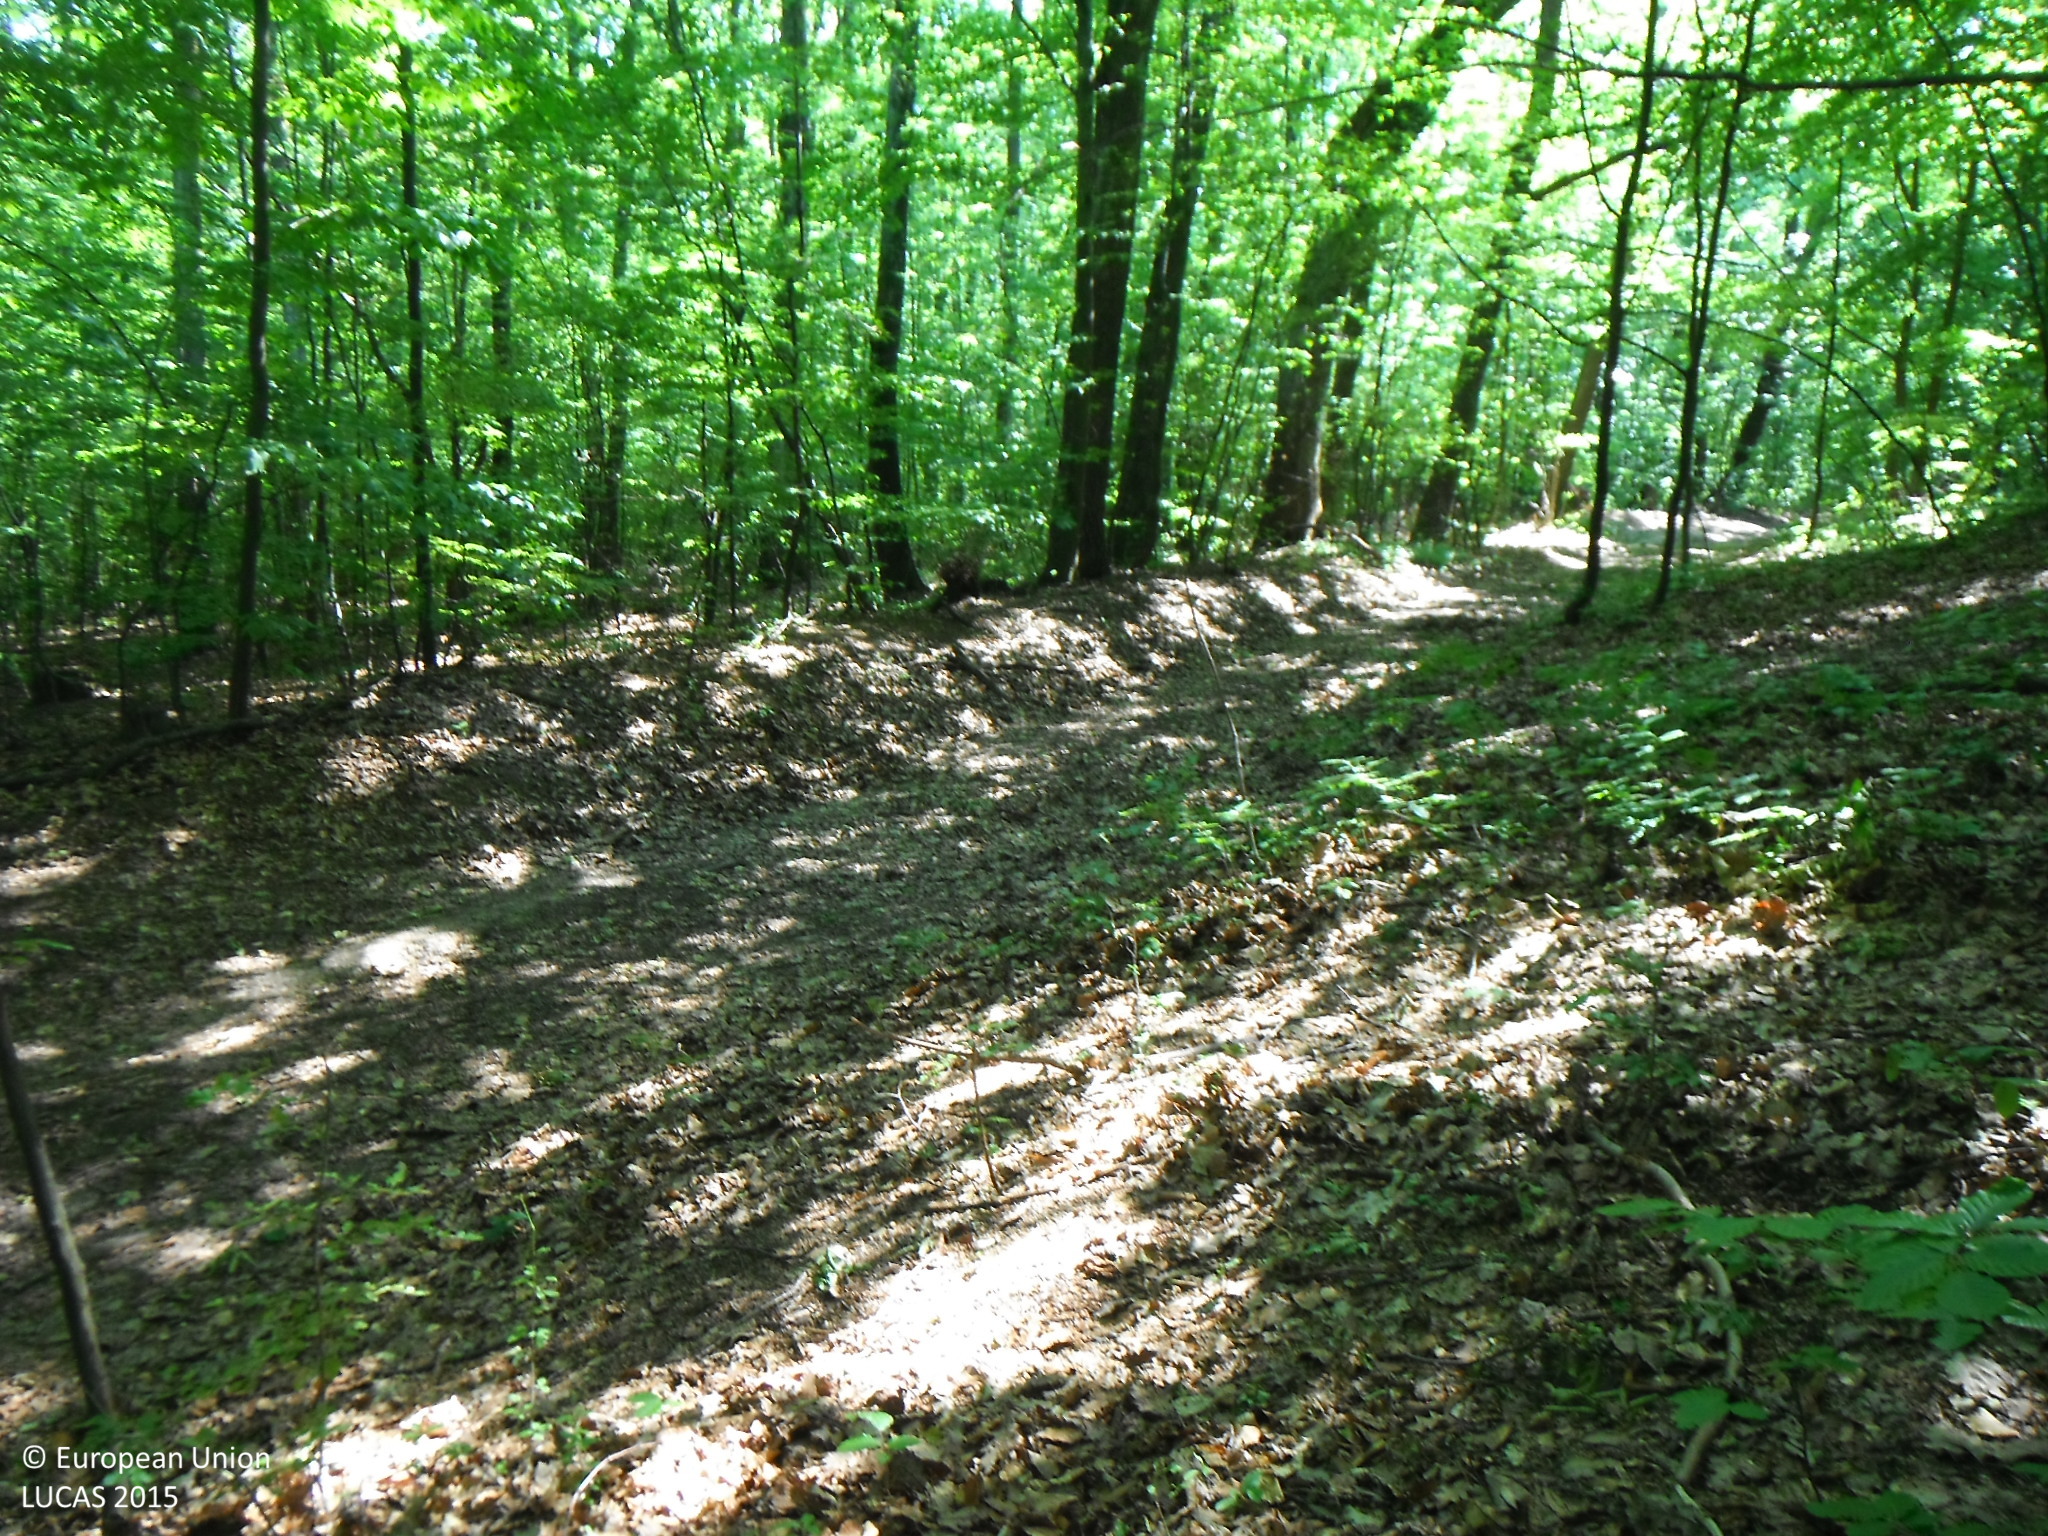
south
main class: Woodland
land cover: Broadleaved woodland
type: beech forest
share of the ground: > 75 %
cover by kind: broadleaved forest trees 95 %, shrubs 5 %
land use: Forestry
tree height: > 5 m
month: June
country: SK
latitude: 48.8674
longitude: 21.9005
